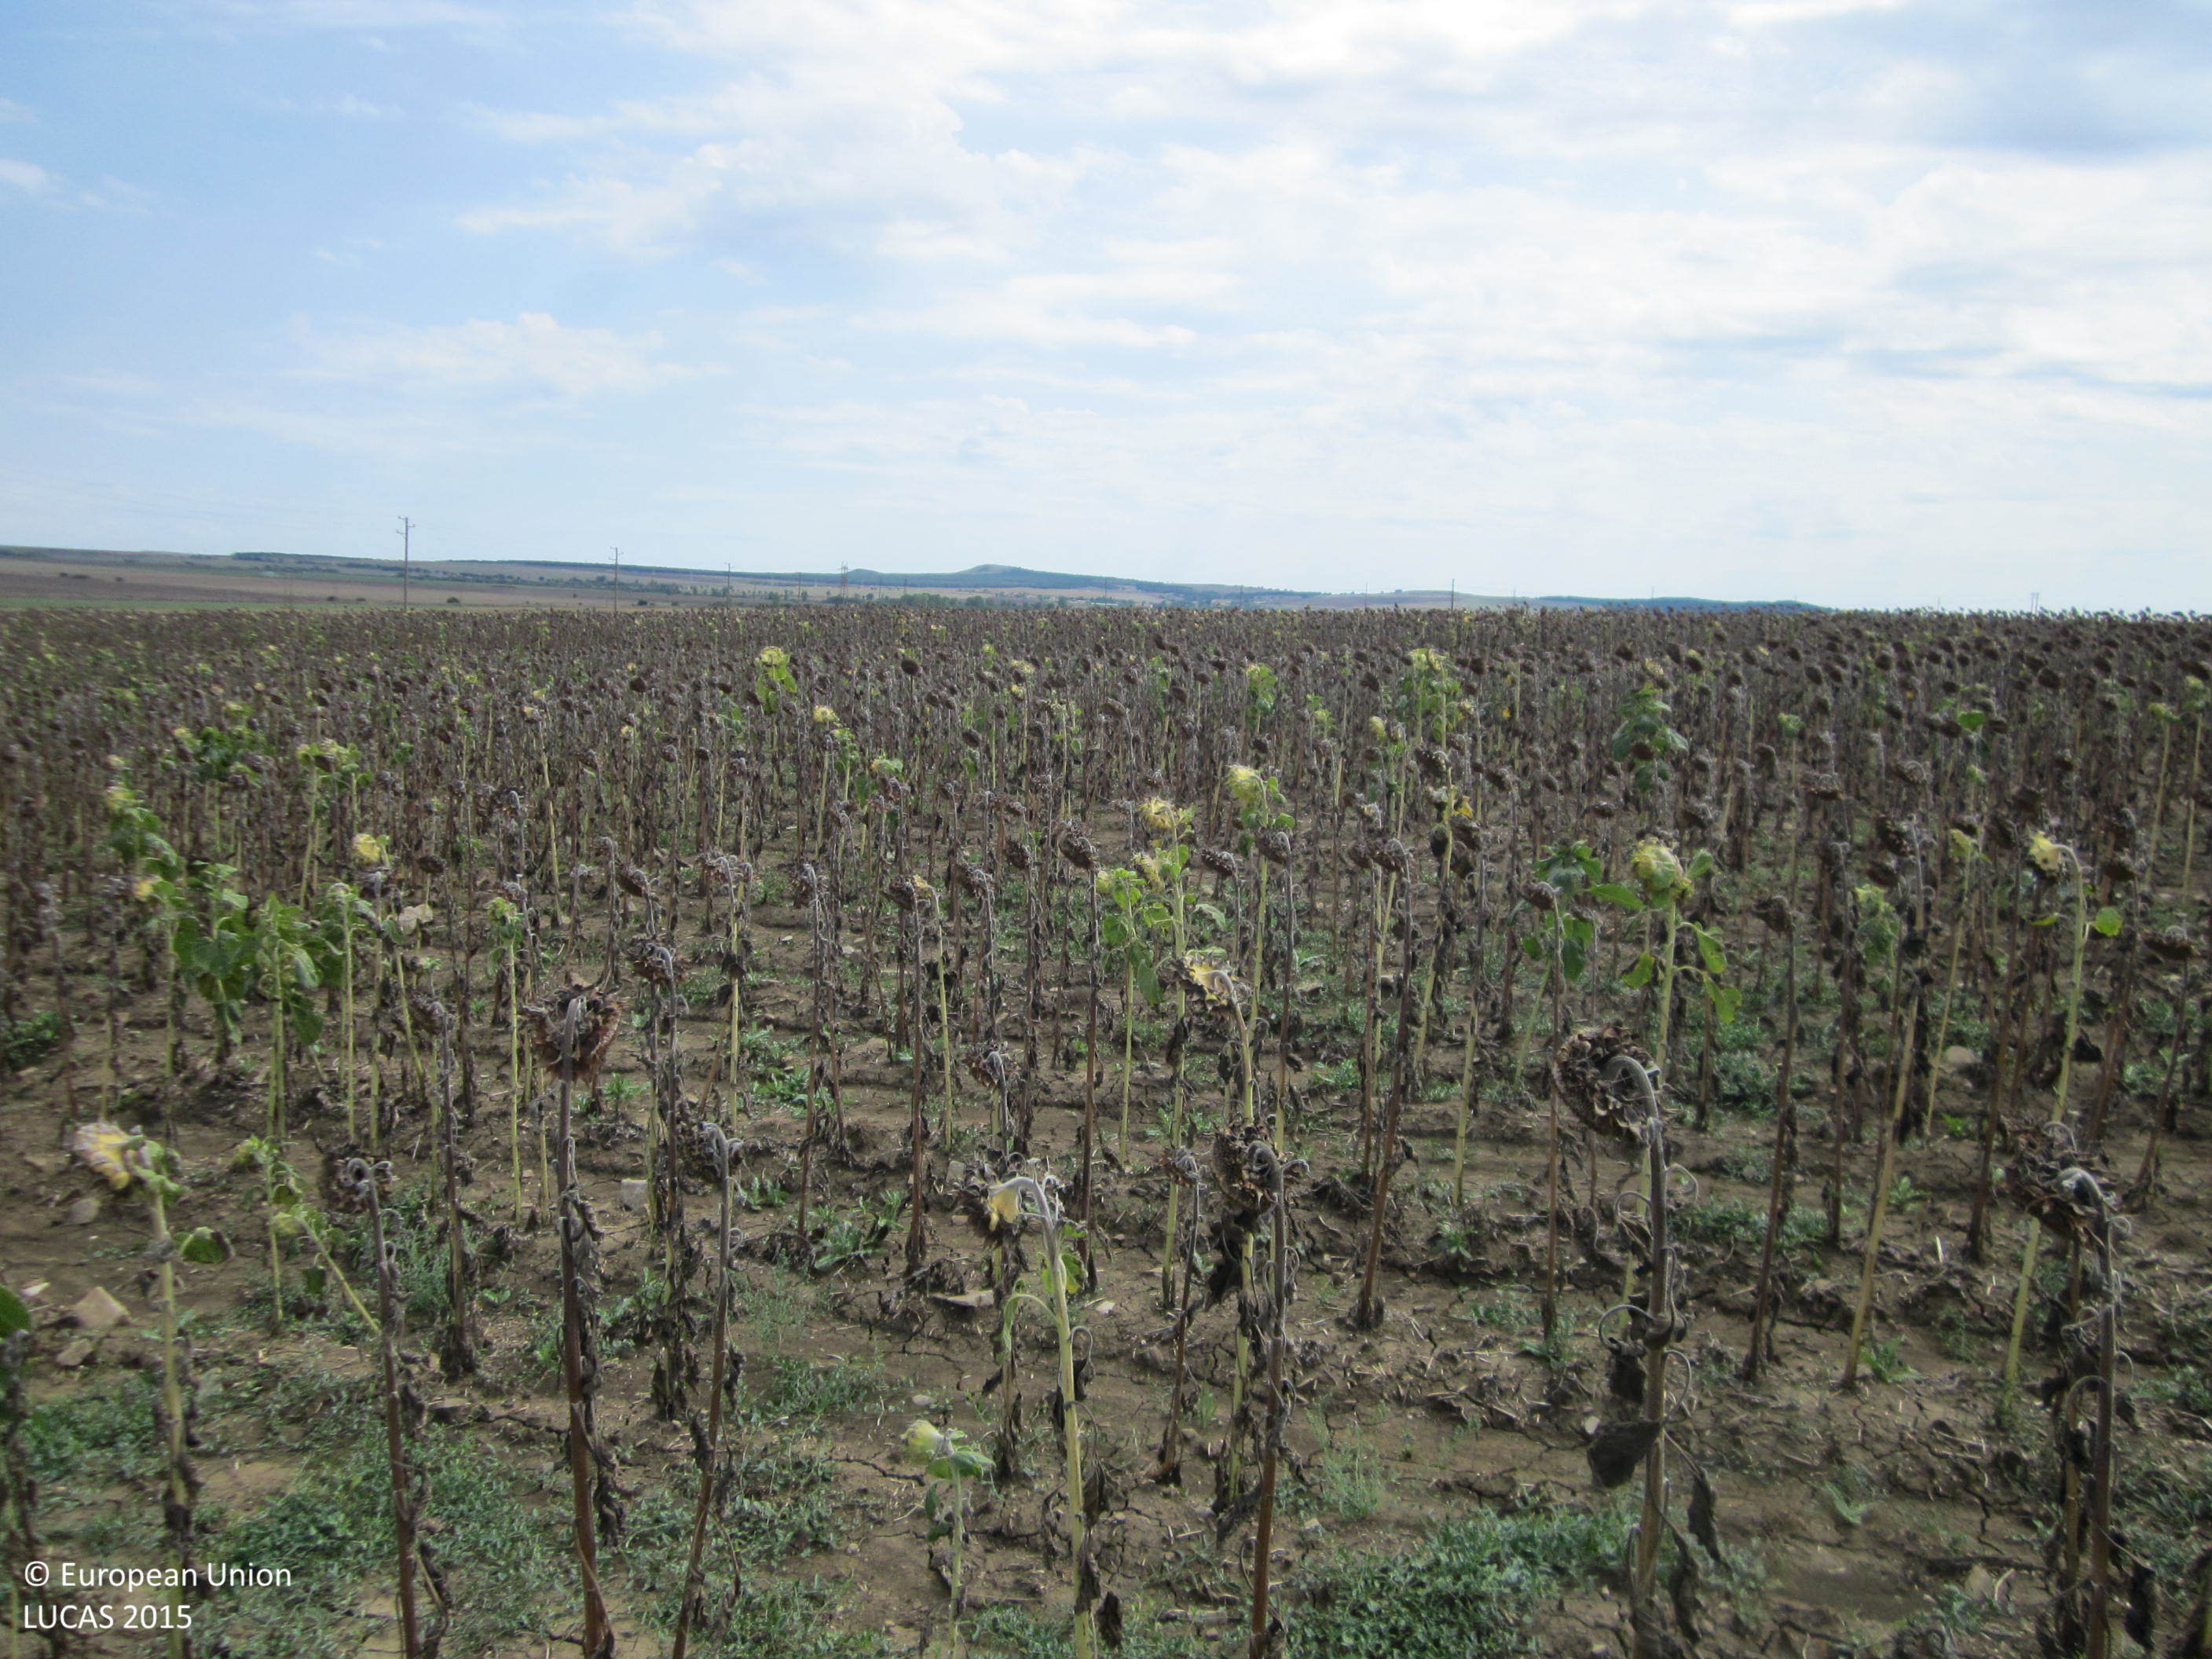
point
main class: Cropland
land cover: Sunflower
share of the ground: 50 - 75 %
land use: Agriculture (excluding fallow land and kitchen gardens)
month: September
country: BG
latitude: 42.6896
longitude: 27.0371
